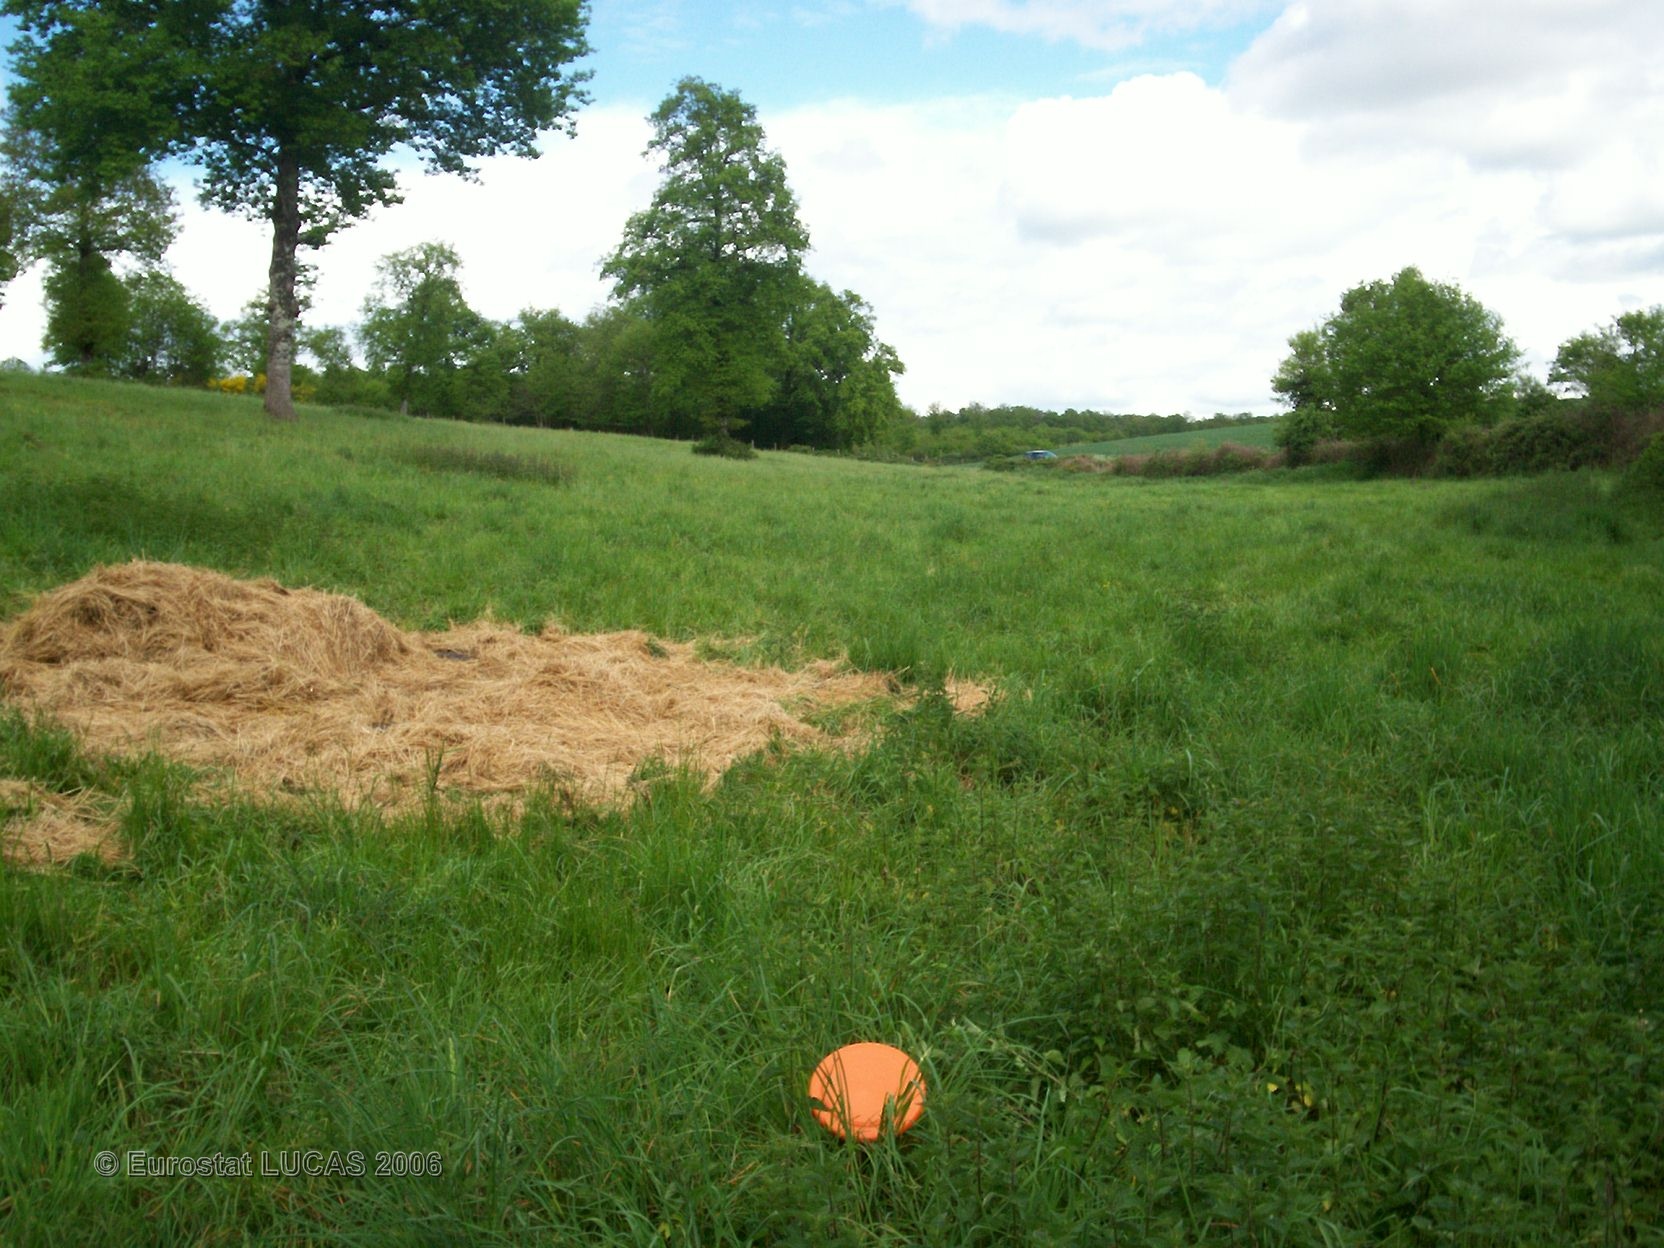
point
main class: Grassland
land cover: Grassland without tree/shrub cover
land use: Agriculture (excluding fallow land and kitchen gardens)
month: May
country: FR
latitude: 45.9771
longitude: 0.4461
